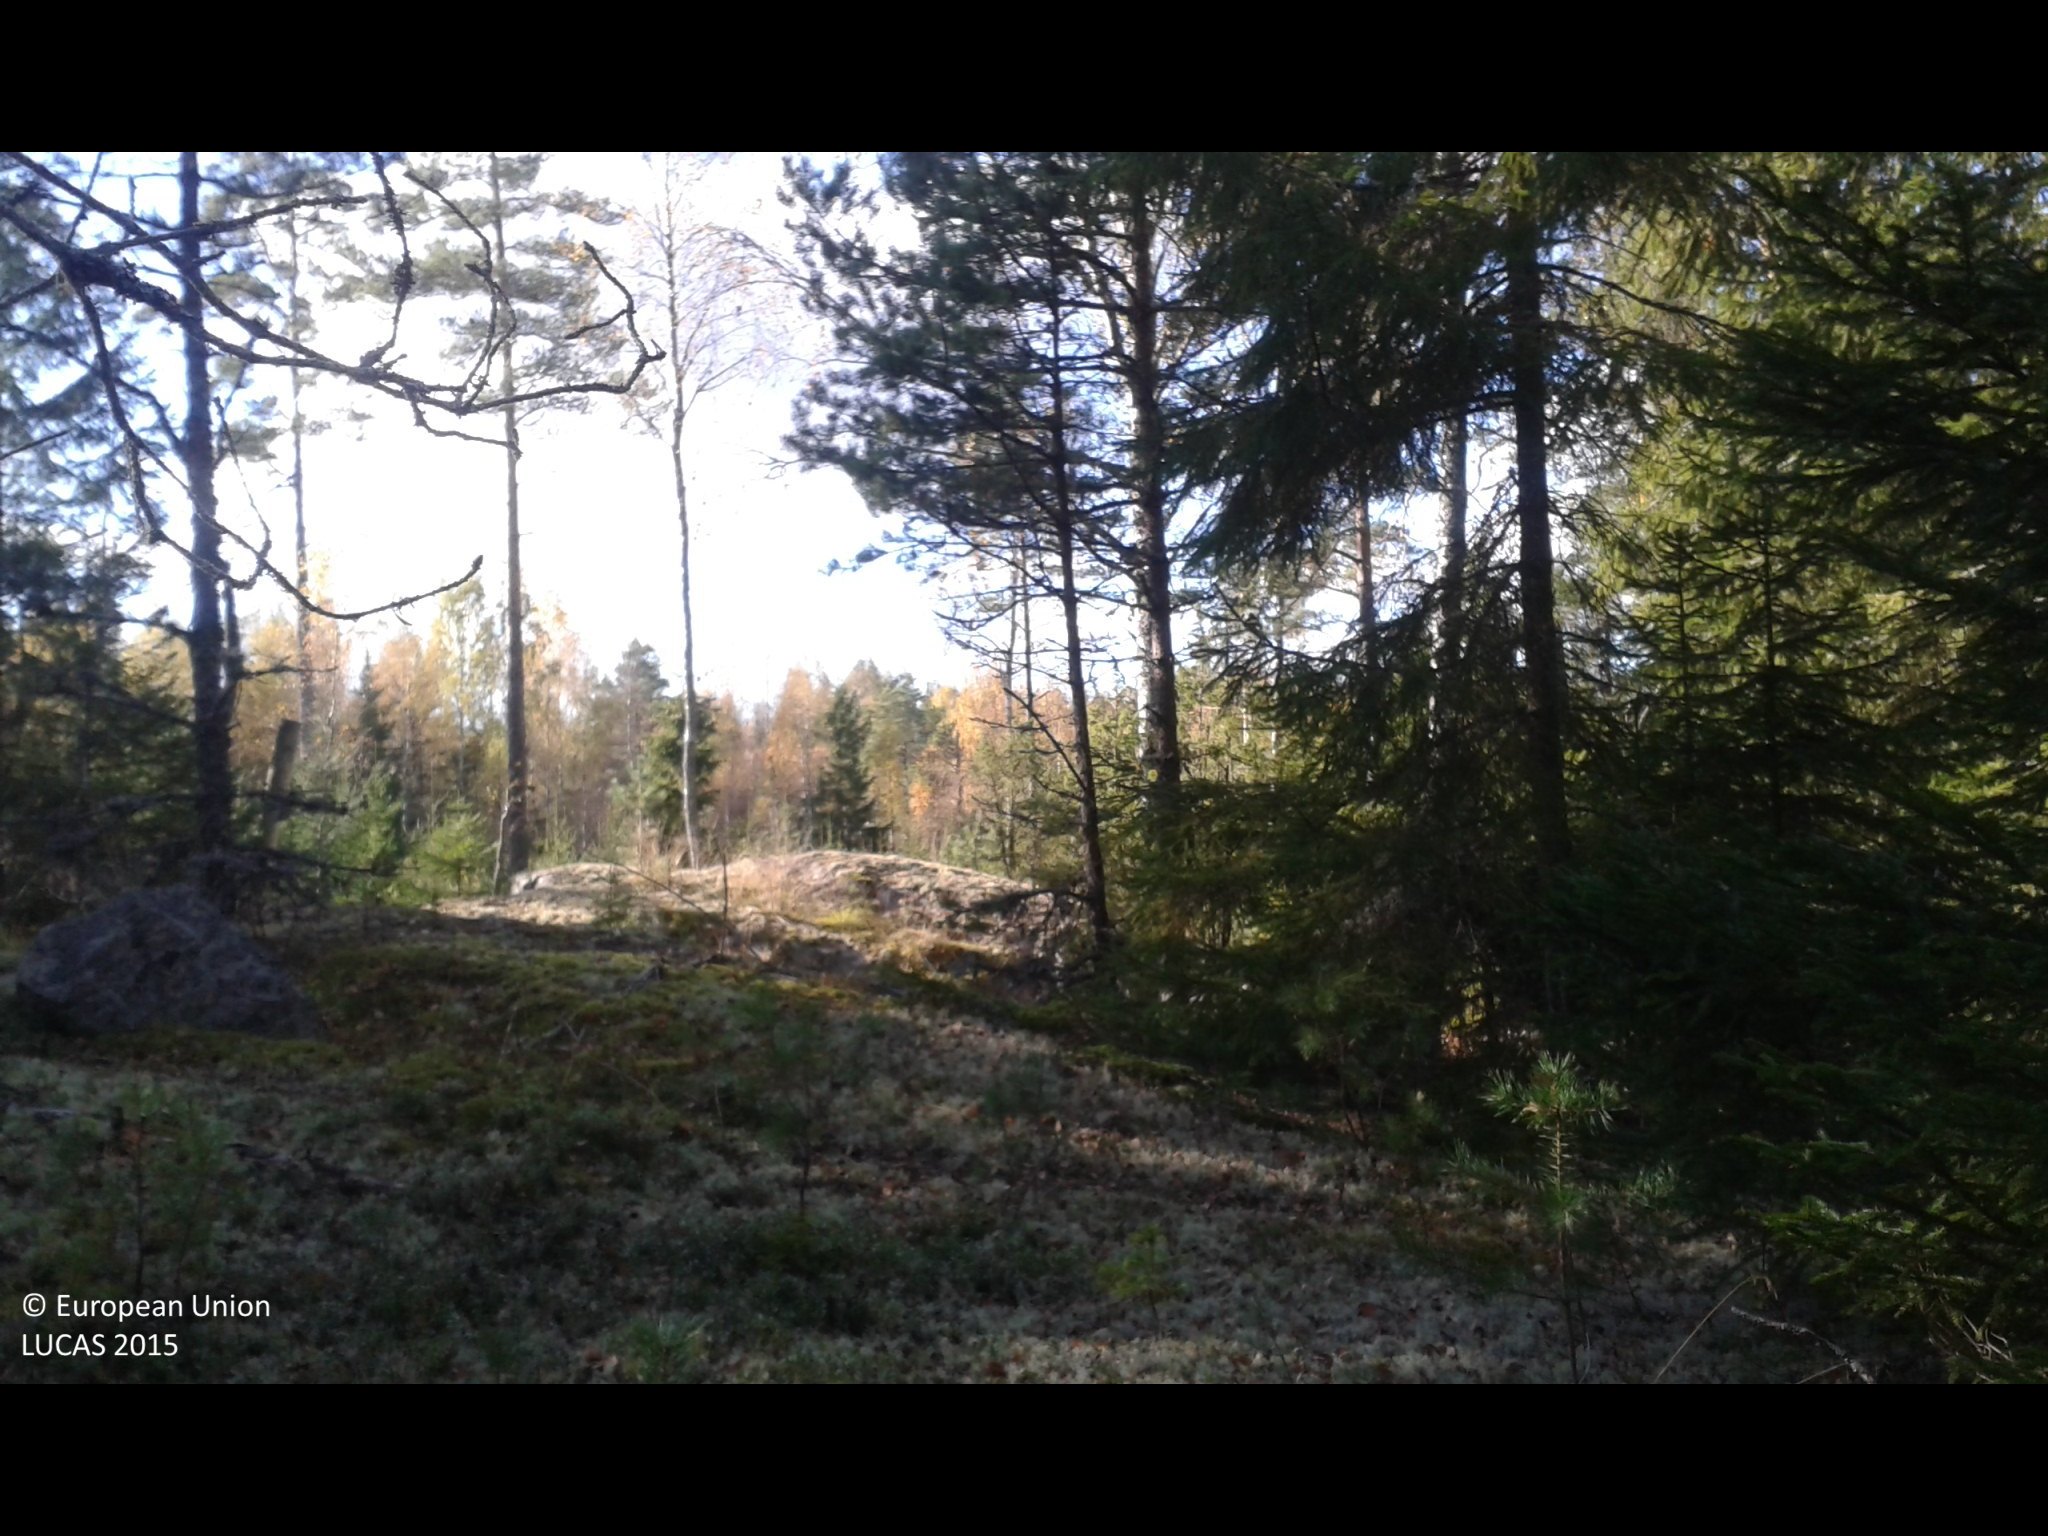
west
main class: Woodland
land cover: Other coniferous woodland
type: boreal forest
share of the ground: 25 - 50 %
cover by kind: herbaceous plants 40 %, coniferous forest trees 35 %, lichens and mosses 20 %, broadleaved forest trees 5 %
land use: Forestry
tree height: > 5 m
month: October
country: SE
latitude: 58.7990
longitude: 17.2836
